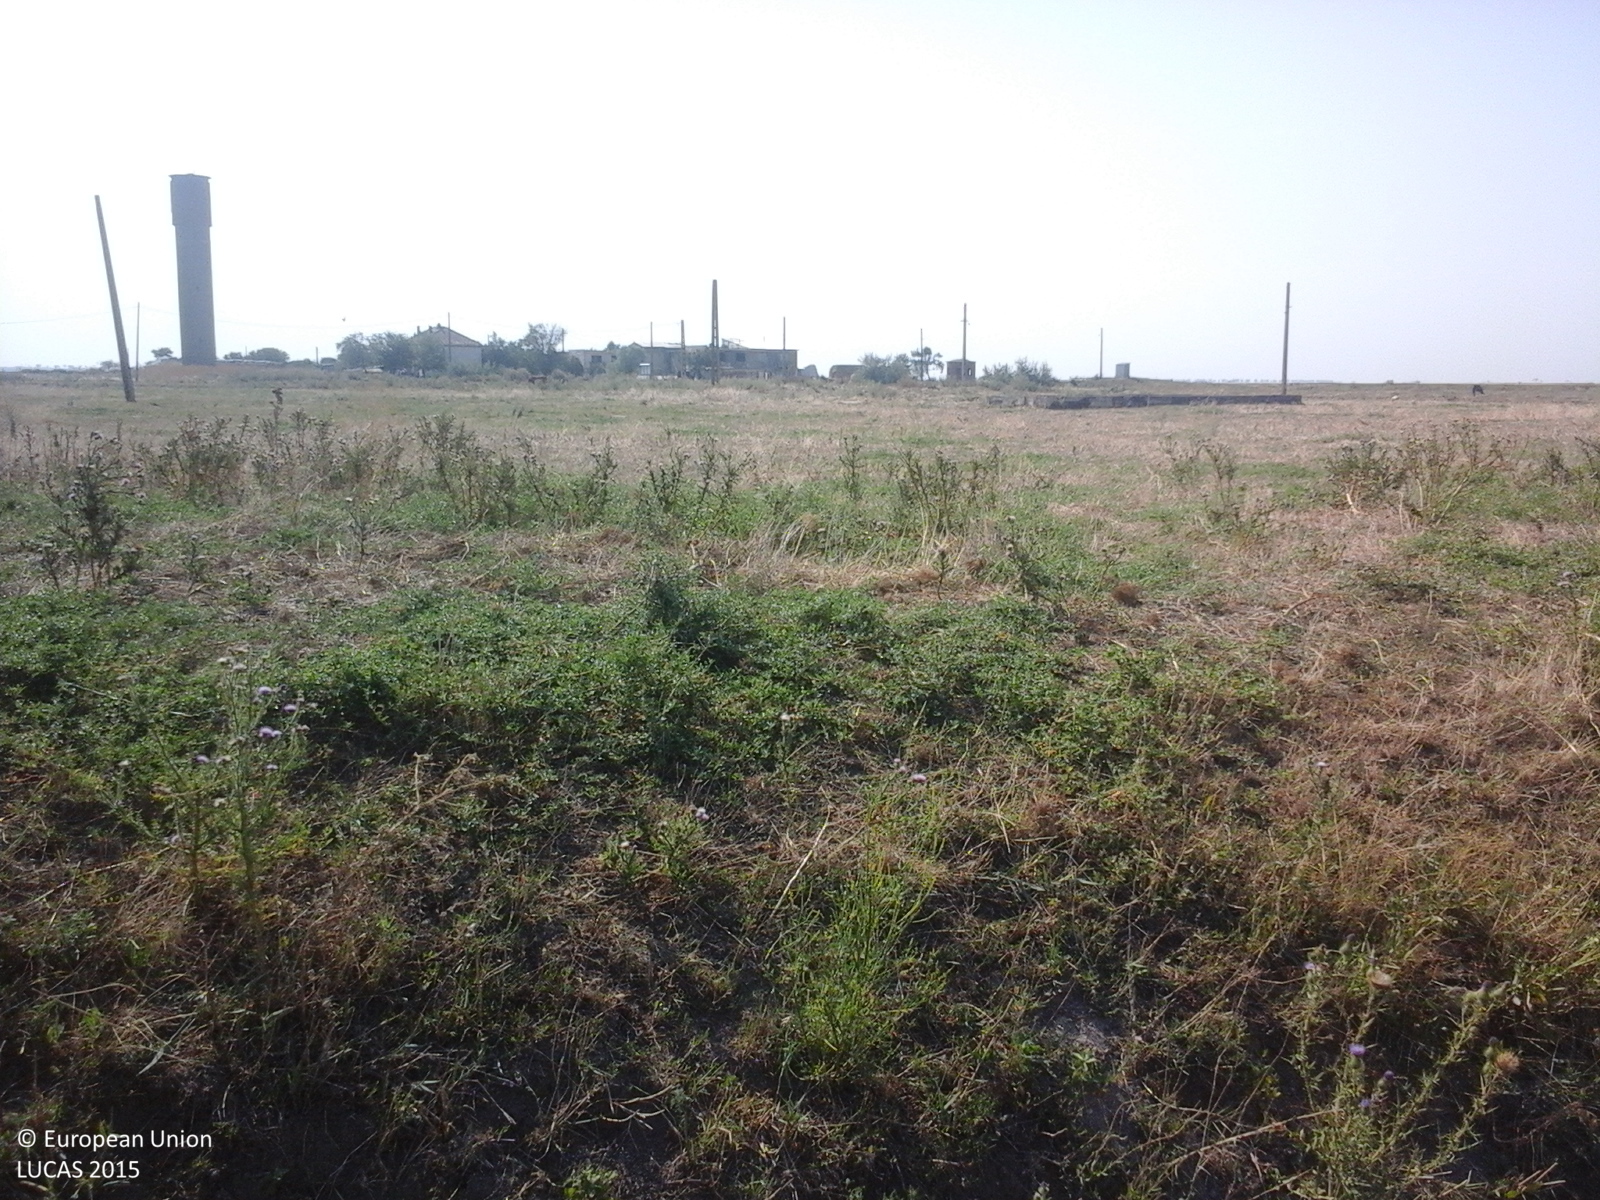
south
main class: Grassland
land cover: Grassland without tree/shrub cover
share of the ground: > 75 %
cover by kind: herbaceous plants 100 %
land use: Agriculture (excluding fallow land and kitchen gardens)
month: August
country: RO
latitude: 45.3644
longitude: 27.7659
